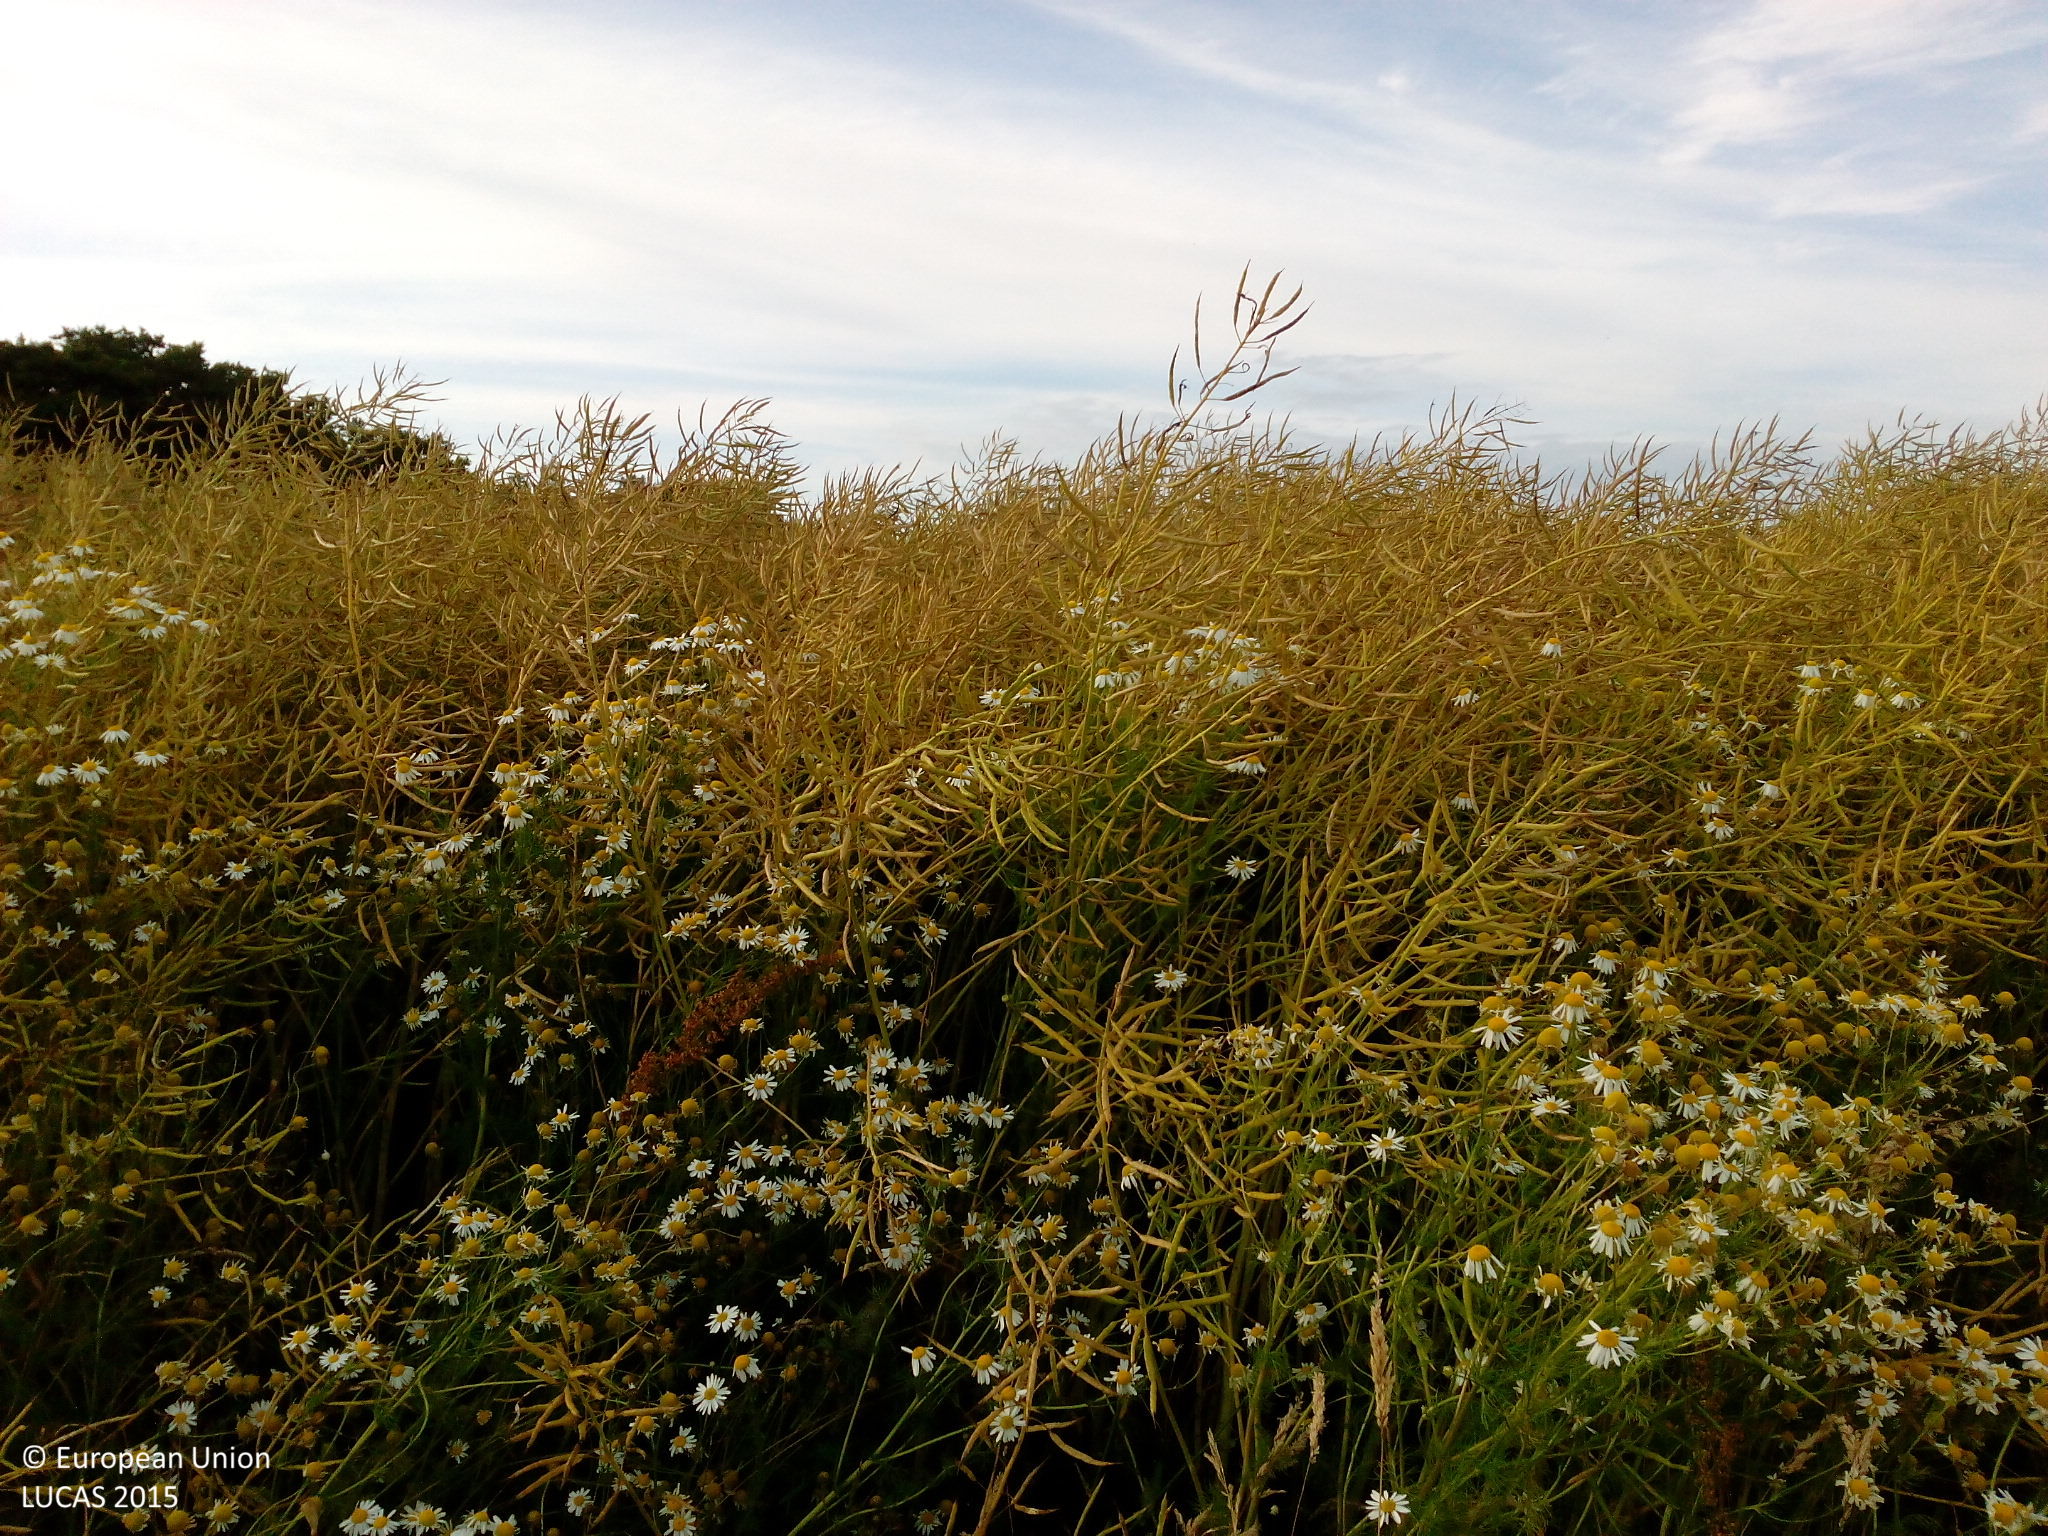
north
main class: Cropland
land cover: Rape and turnip rape
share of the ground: > 75 %
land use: Agriculture (excluding fallow land and kitchen gardens)
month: July
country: DK
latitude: 55.9374
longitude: 12.0632
